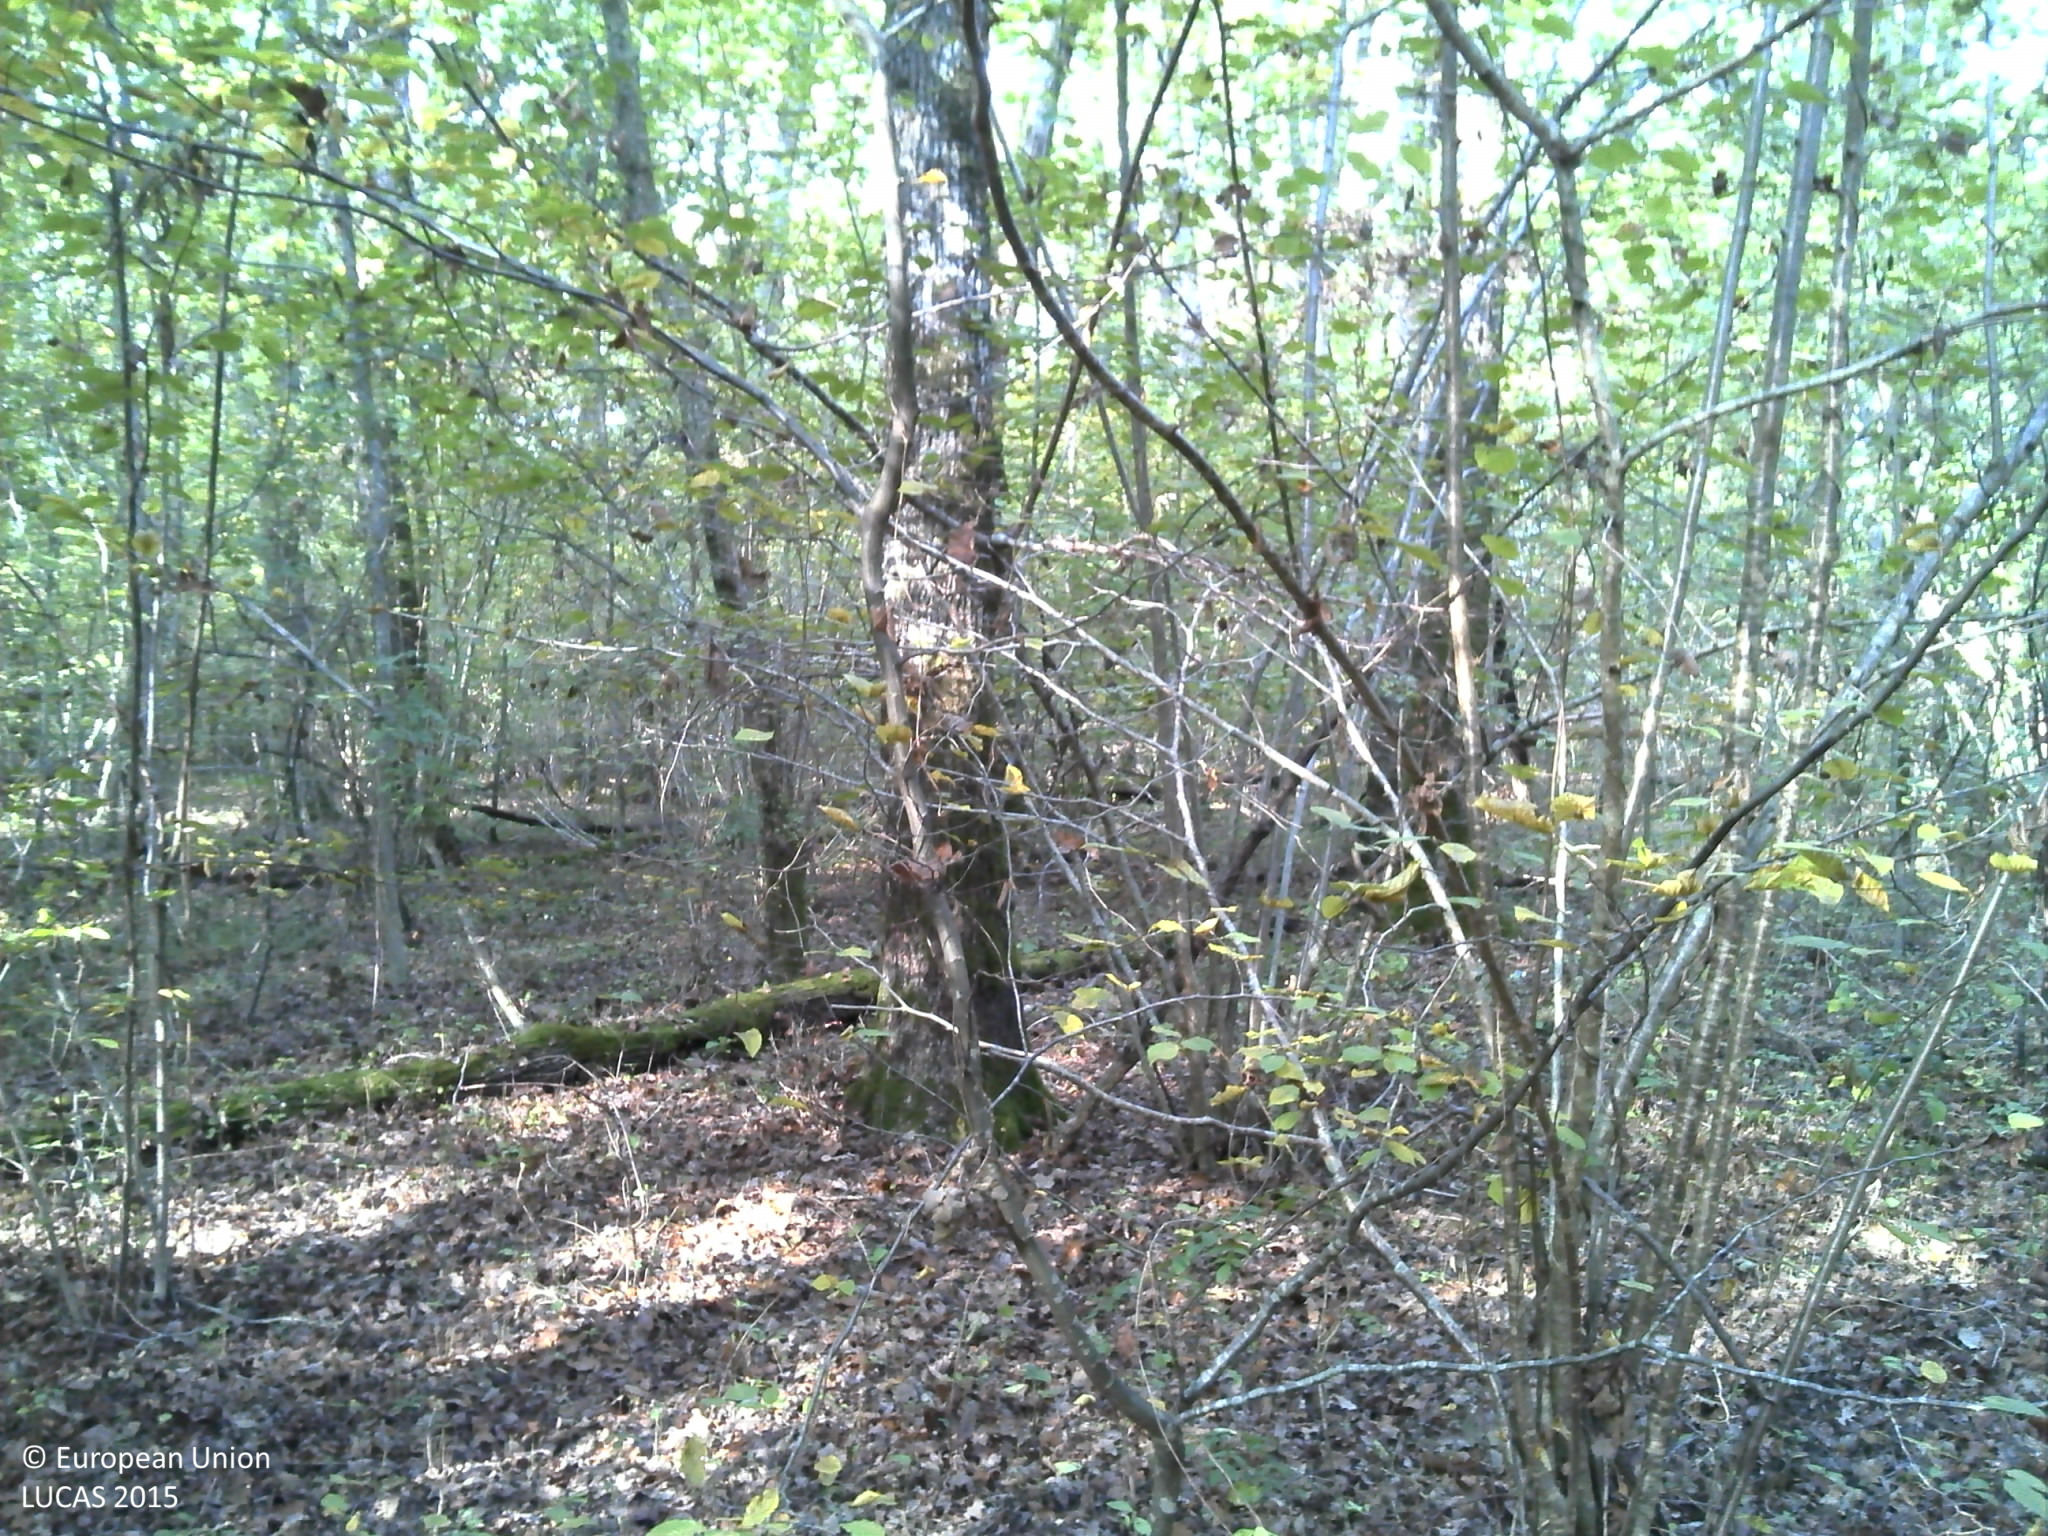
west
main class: Woodland
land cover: Broadleaved woodland
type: mesophytic deciduous forest
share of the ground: > 75 %
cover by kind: broadleaved forest trees 90 %, herbaceous plants 5 %, unconsolidated bare surface 5 %
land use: Forestry
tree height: > 5 m
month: October
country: FR
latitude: 46.2800
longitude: 6.0969
